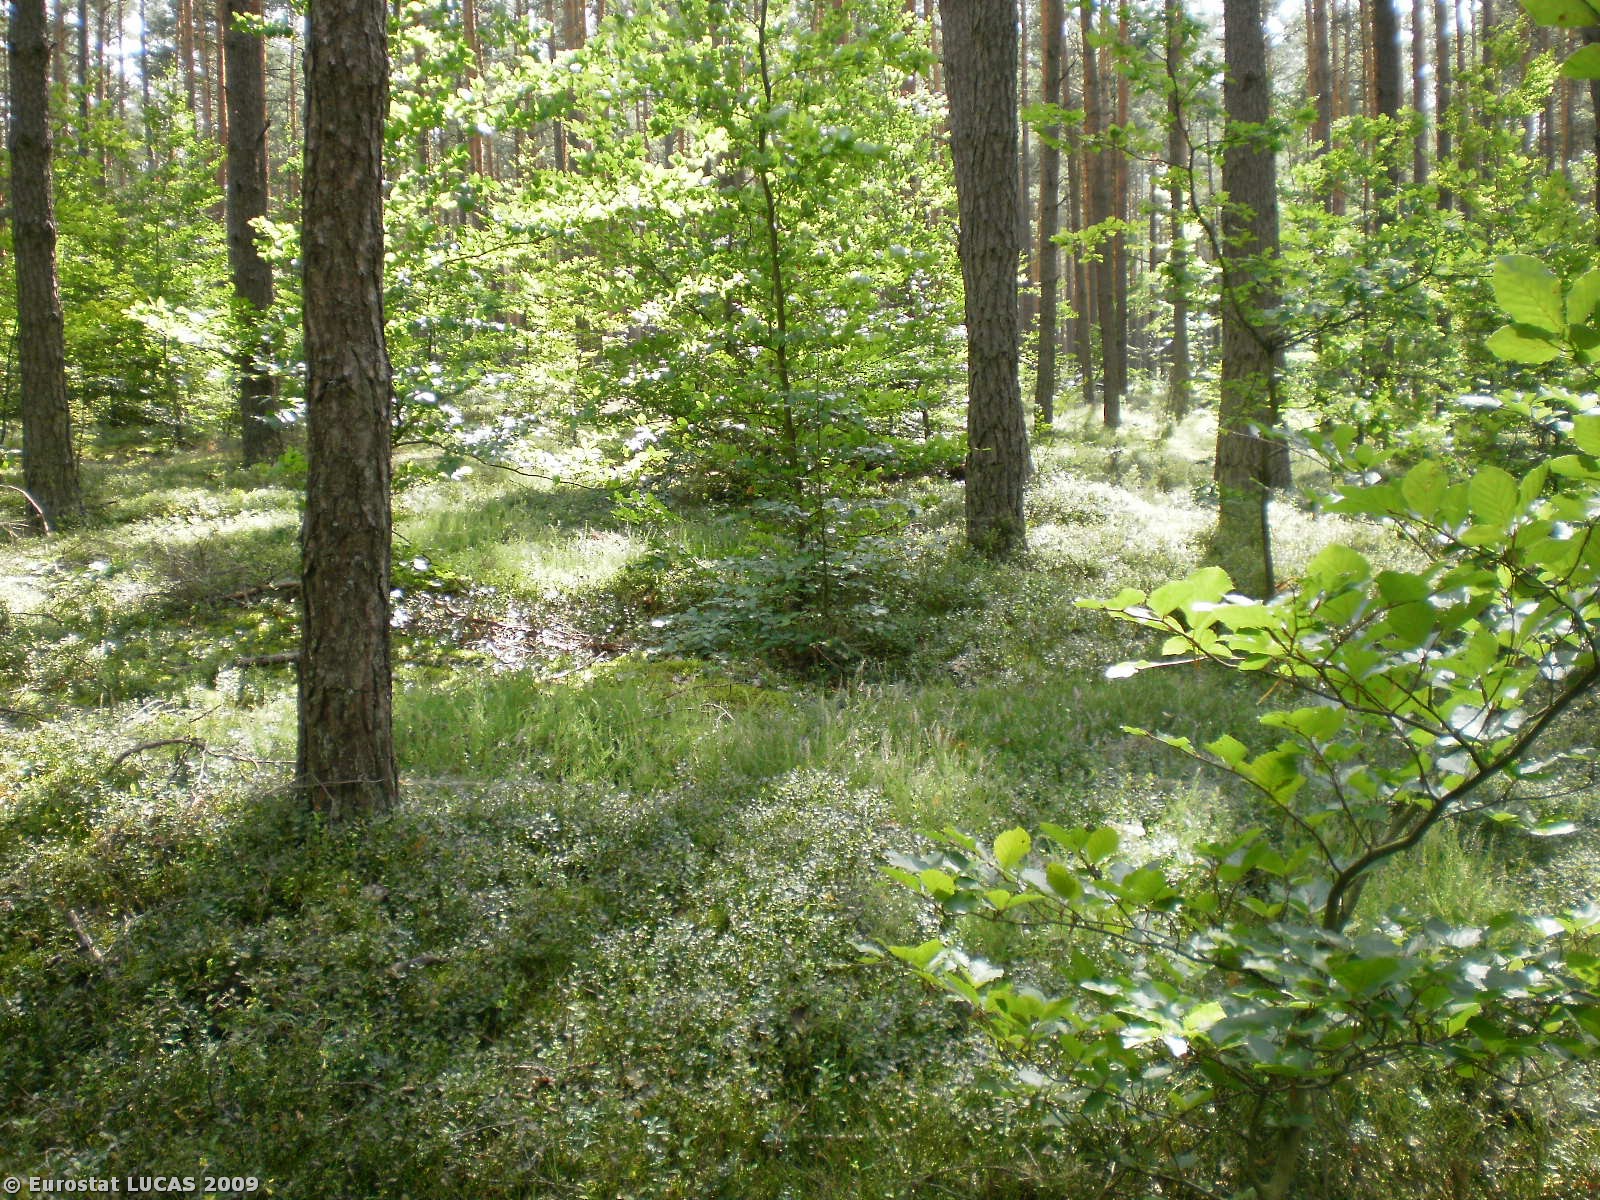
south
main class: Woodland
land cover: Coniferous woodland
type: hemiboreal forest and nemoral coniferous forest and mixed broadleaved-coniferous forest
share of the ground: > 75 %
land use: Forestry
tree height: > 5 m
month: August
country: PL
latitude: 52.7377
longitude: 21.7400
